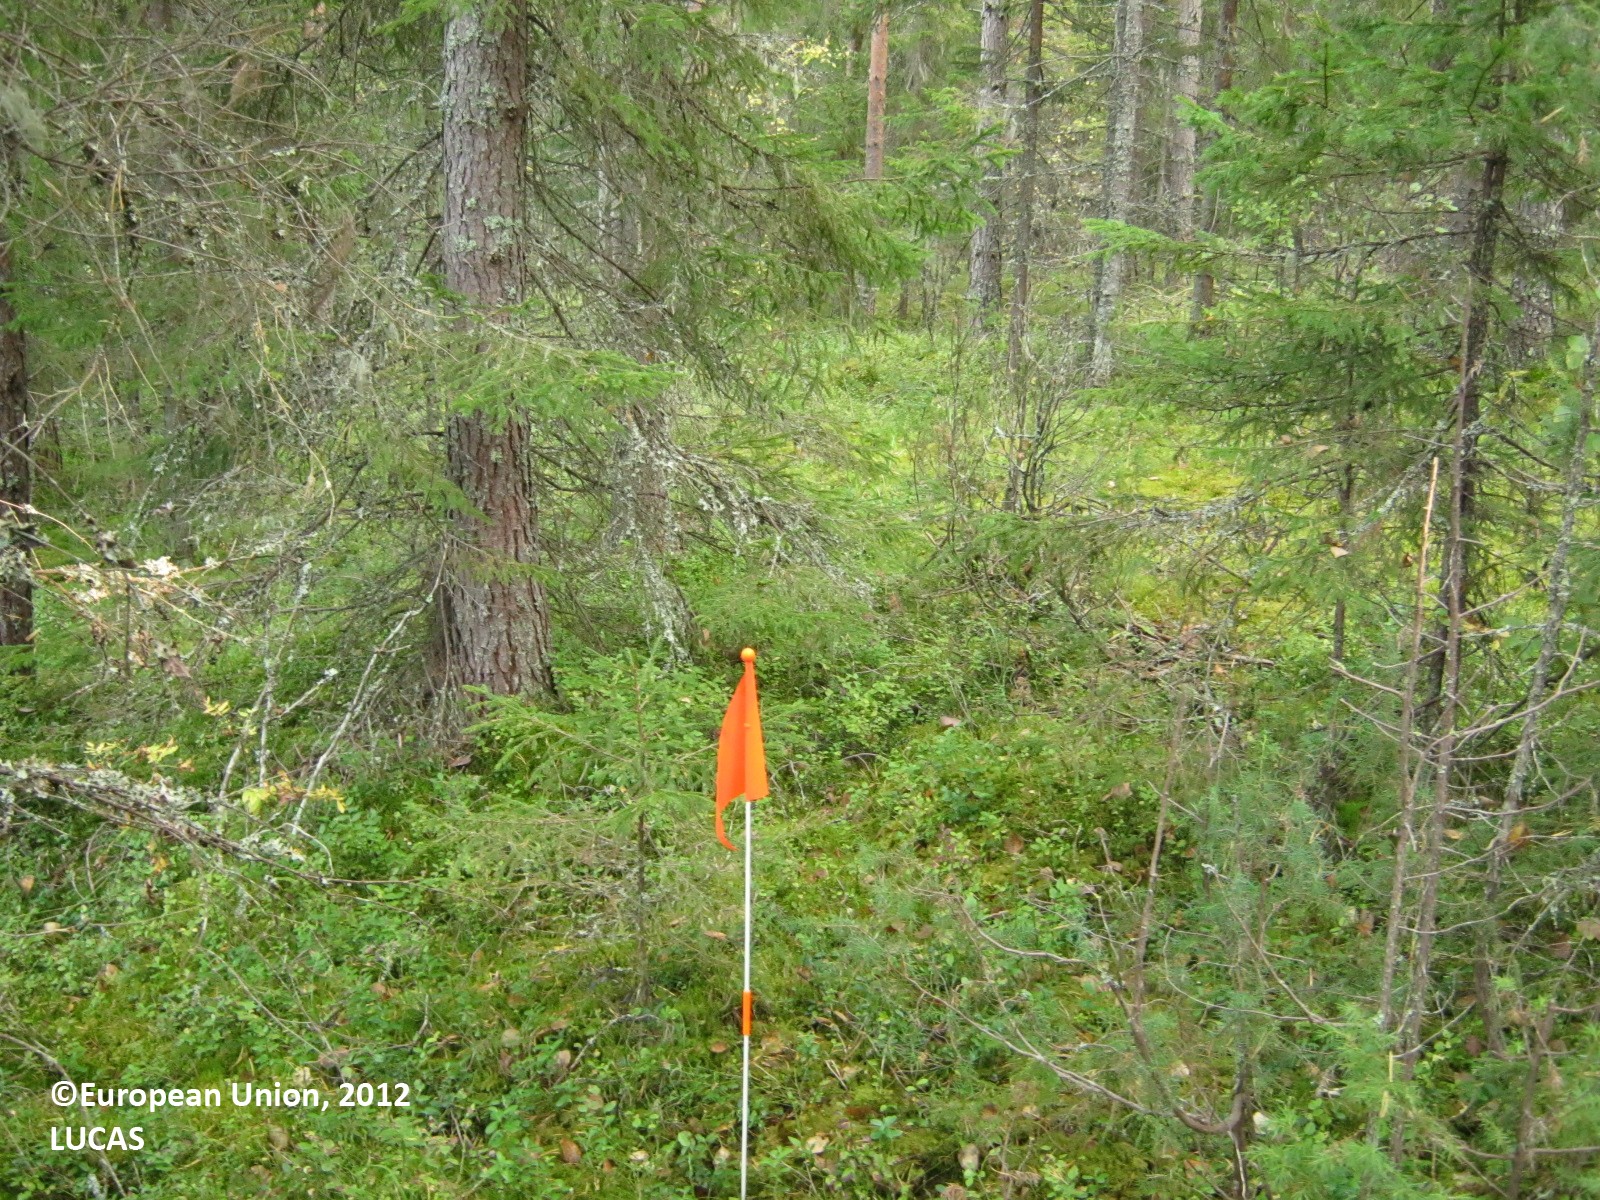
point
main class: Woodland
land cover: Other coniferous woodland
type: boreal forest
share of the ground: > 75 %
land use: Forestry
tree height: > 5 m
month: September
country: FI
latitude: 60.8925
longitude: 27.9067
